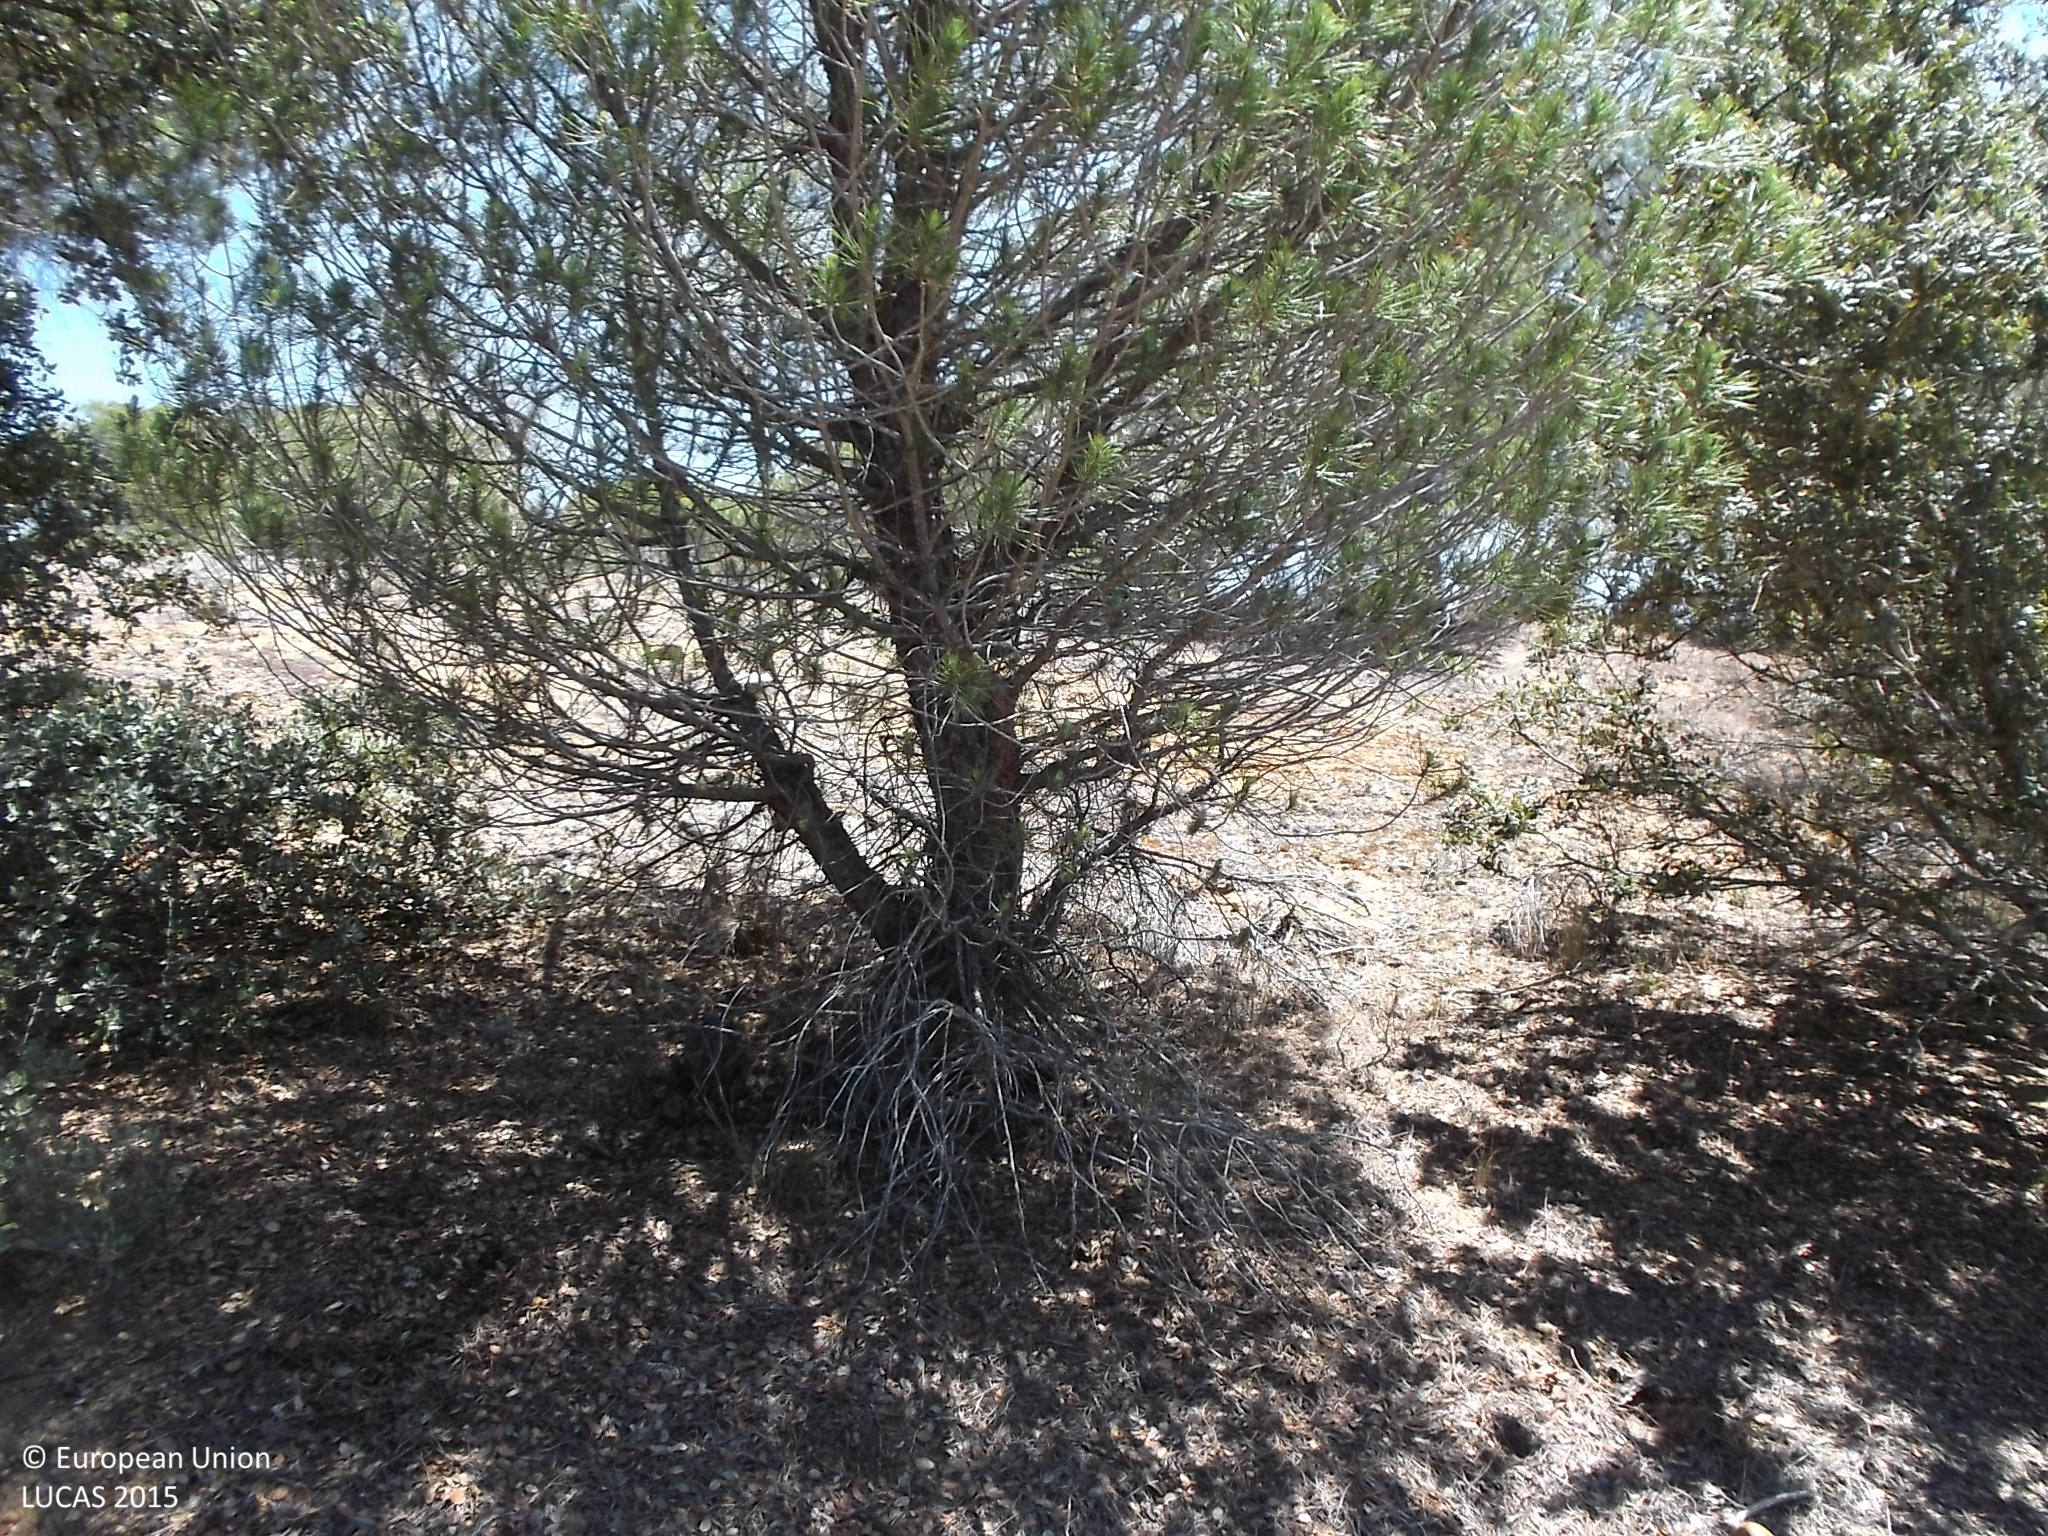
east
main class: Woodland
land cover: Other mixed woodland
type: coniferous forest of the mediterranean region
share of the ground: 50 - 75 %
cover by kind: coniferous forest trees 50 %, broadleaved forest trees 20 %, shrubs 20 %, herbaceous plants 10 %
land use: Forestry
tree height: > 5 m
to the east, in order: Other mixed woodland; Pine dominated mixed woodland; Other mixed woodland
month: June
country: ES
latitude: 41.4154
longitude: -5.5019
